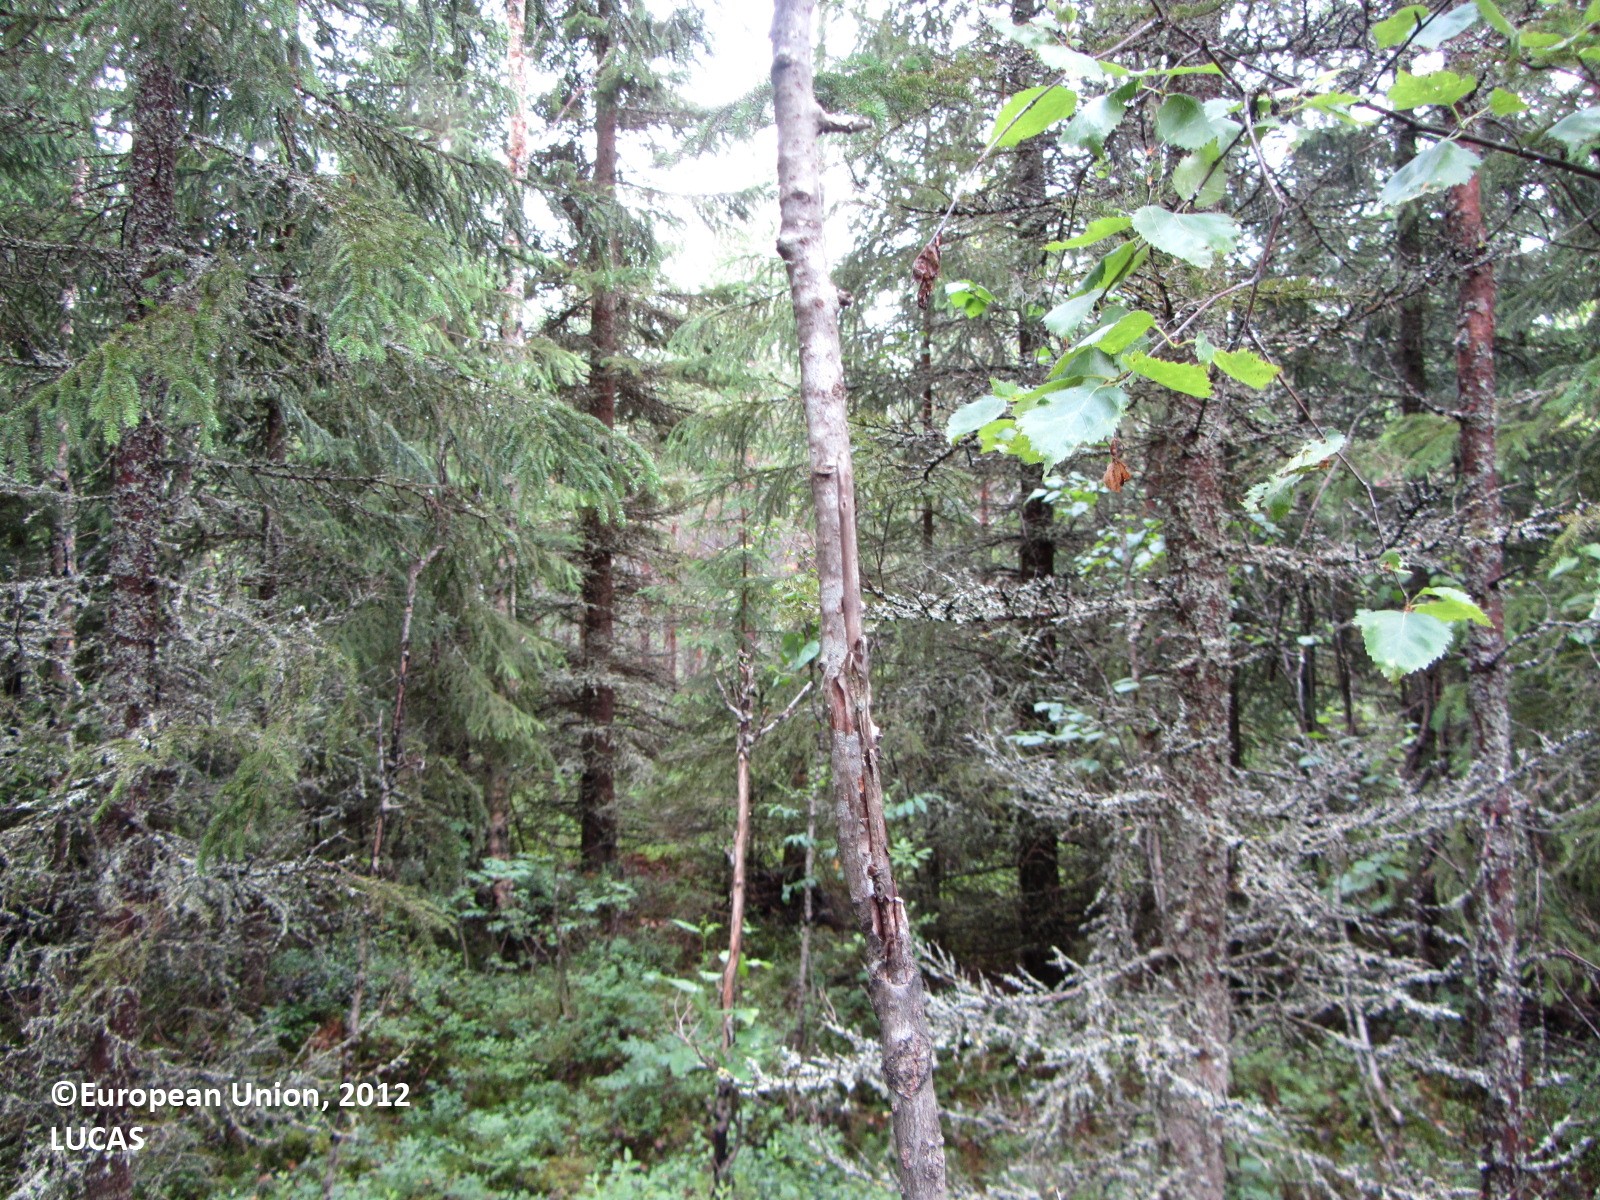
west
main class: Woodland
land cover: Spruce dominated coniferous woodland
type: boreal forest
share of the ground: > 75 %
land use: Forestry
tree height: > 5 m
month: July
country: FI
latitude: 63.8227
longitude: 25.6023
